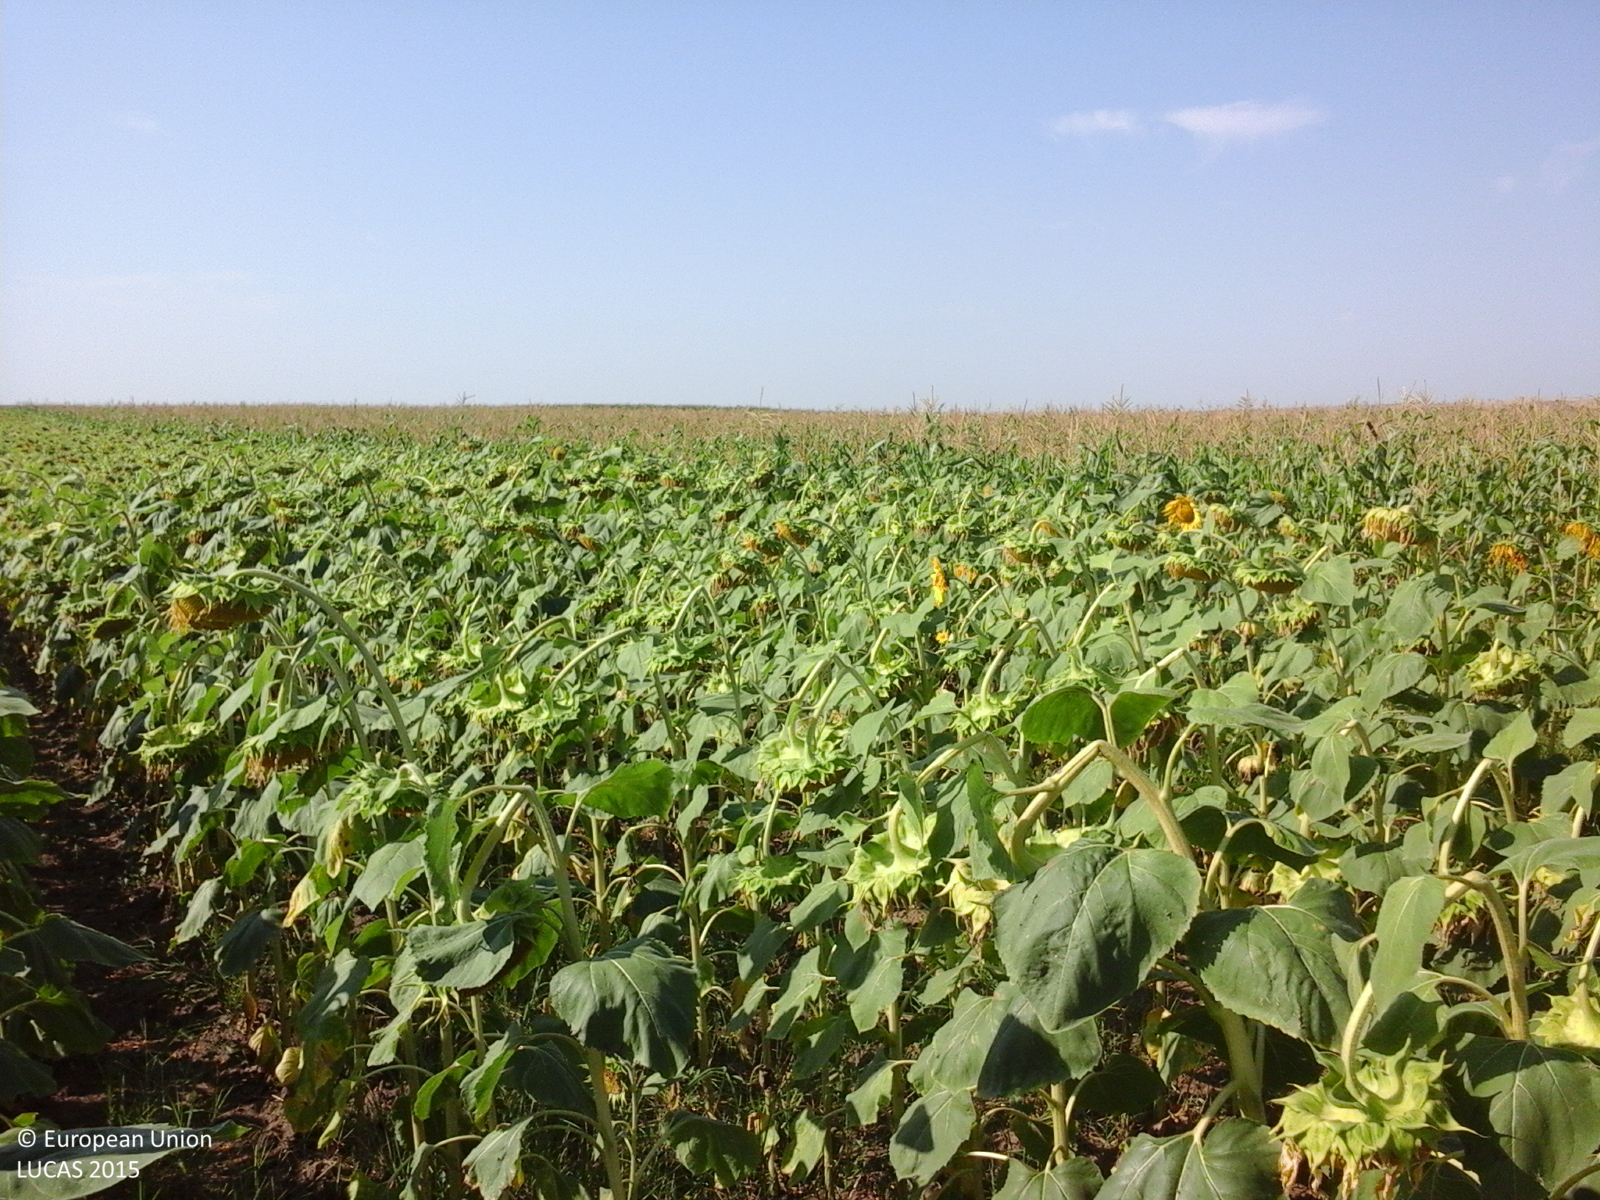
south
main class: Cropland
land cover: Sunflower
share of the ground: > 75 %
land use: Agriculture (excluding fallow land and kitchen gardens)
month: July
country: RO
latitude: 46.1733
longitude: 27.5574
